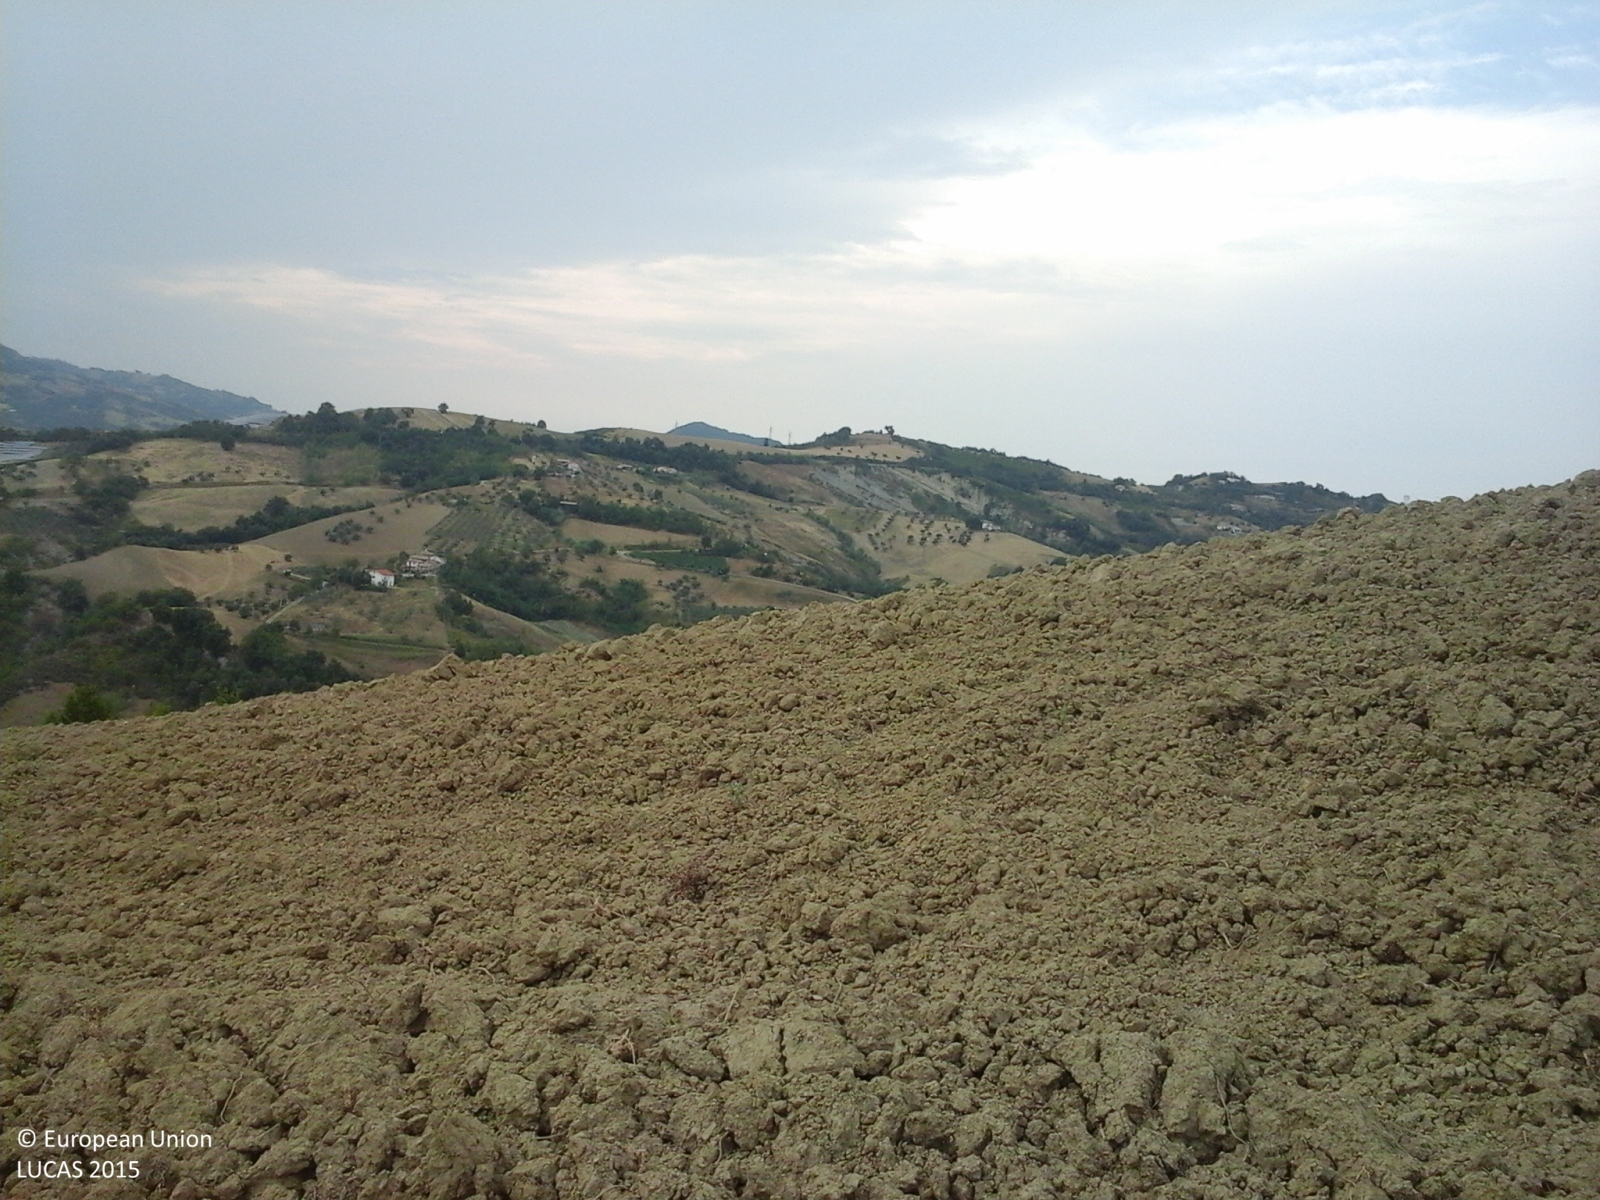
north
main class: Cropland
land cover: Olive groves
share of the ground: 25 - 50 %
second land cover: Spontaneously vegetated surfaces
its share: 25 - 50 %
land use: Agriculture (excluding fallow land and kitchen gardens)
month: August
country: IT
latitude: 42.5087
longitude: 13.8464
